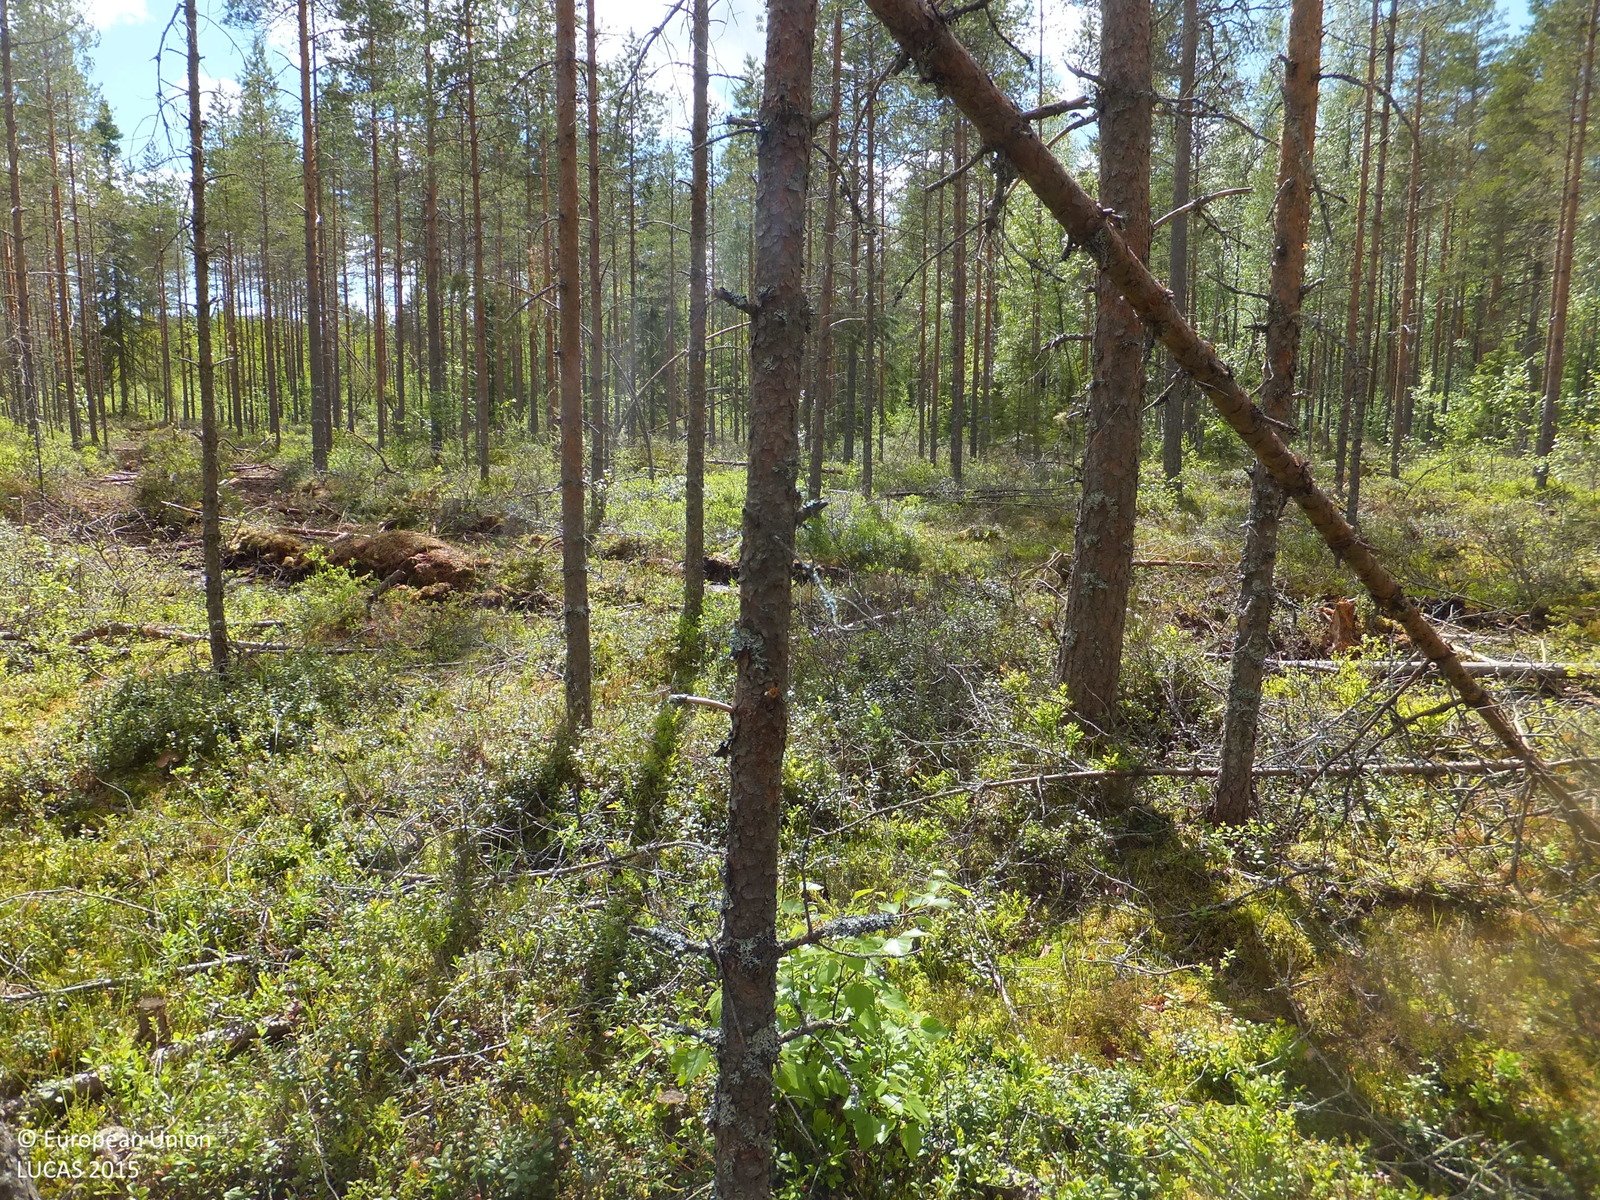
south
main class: Woodland
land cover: Pine dominated coniferous woodland
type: boreal forest
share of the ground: > 75 %
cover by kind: coniferous forest trees 95 %, shrubs 5 %
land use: Forestry
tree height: > 5 m
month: June
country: FI
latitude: 63.4225
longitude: 22.9762
